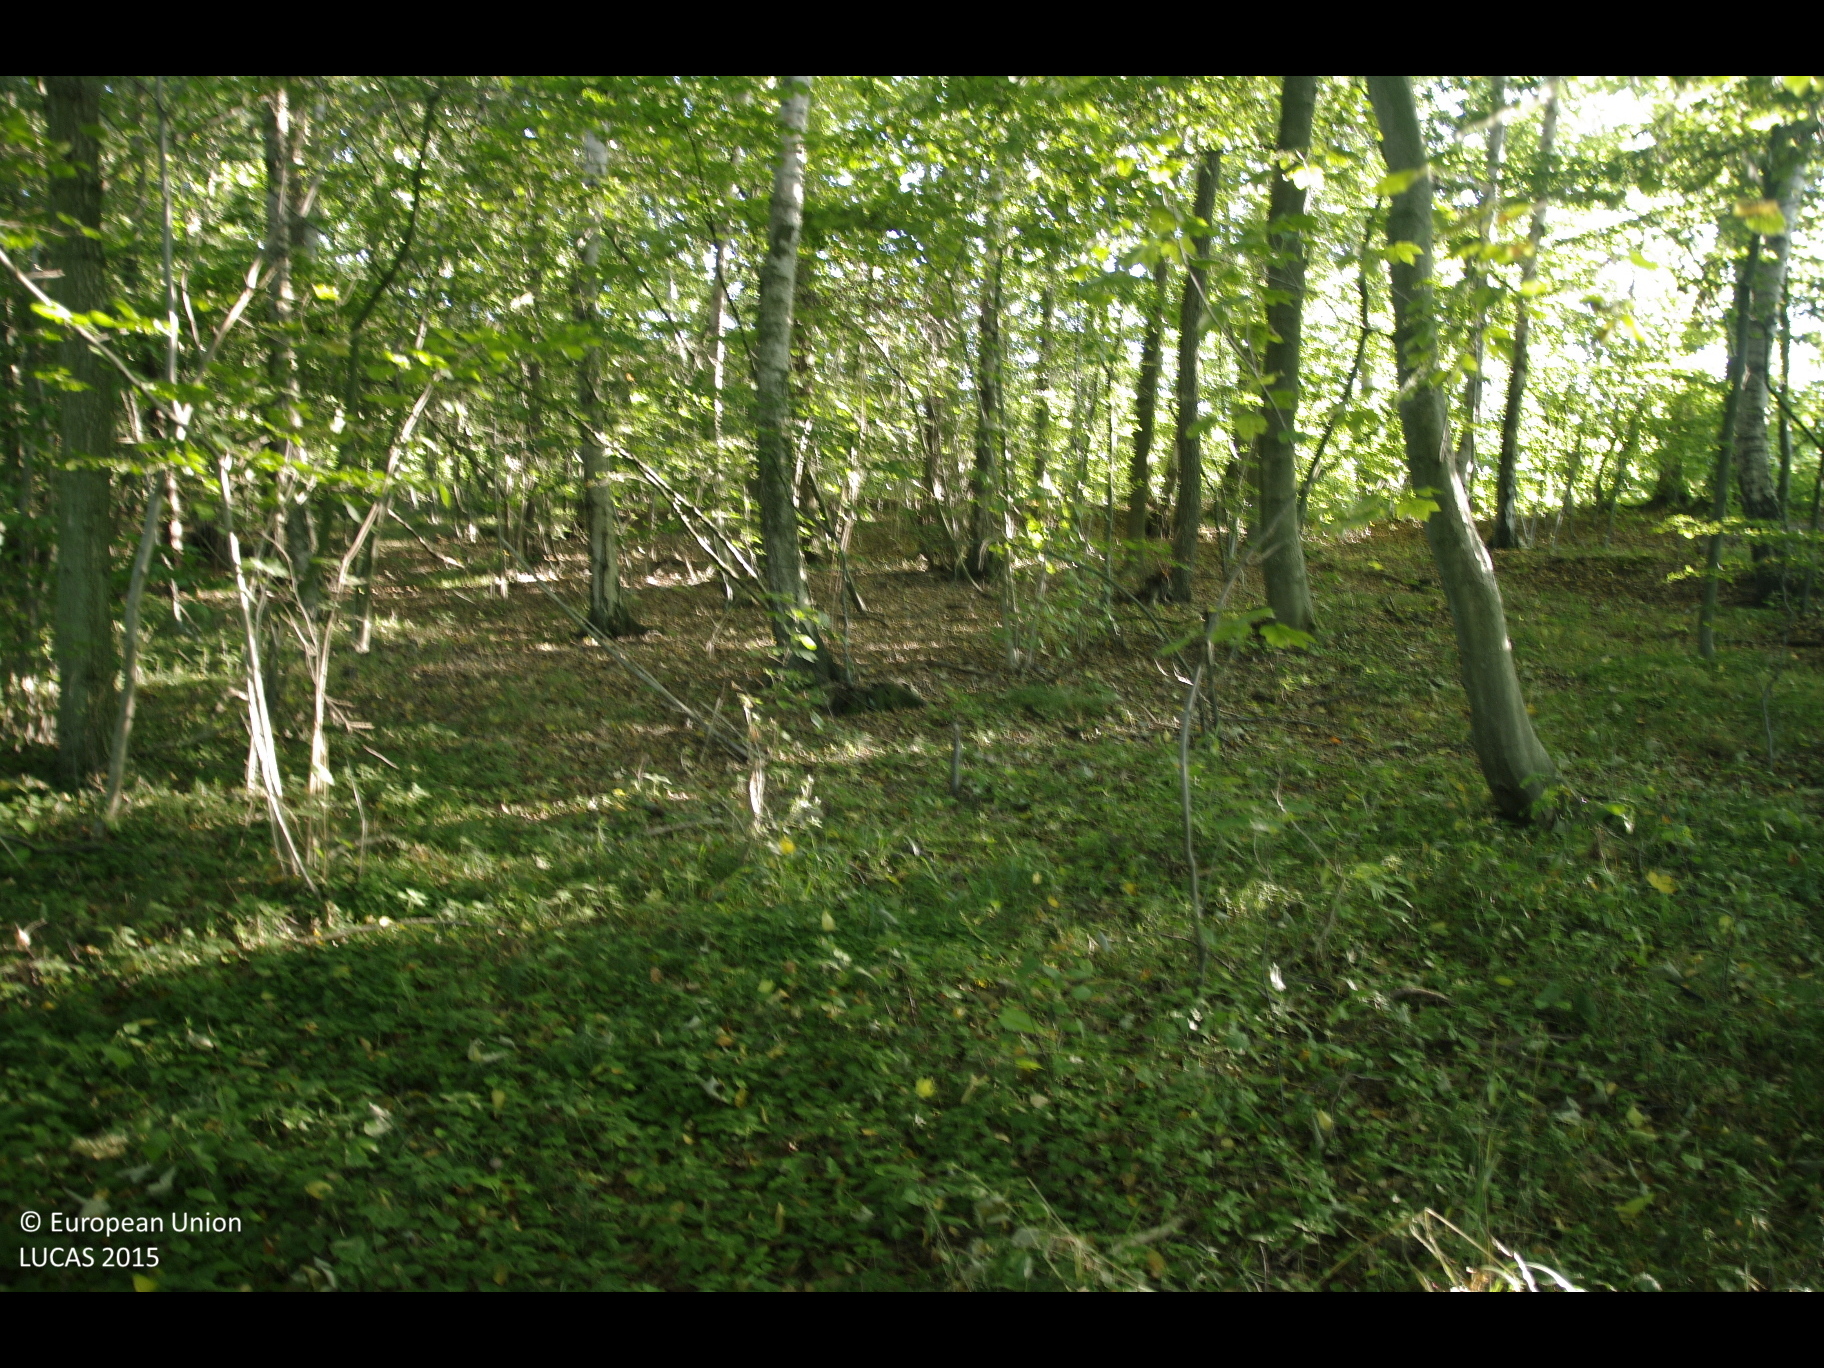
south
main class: Woodland
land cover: Broadleaved woodland
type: mesophytic deciduous forest
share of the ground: > 75 %
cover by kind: broadleaved forest trees 90 %, herbaceous plants 10 %
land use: Semi-natural and natural areas not in use
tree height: > 5 m
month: October
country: DE
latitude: 53.5082
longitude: 10.6179
